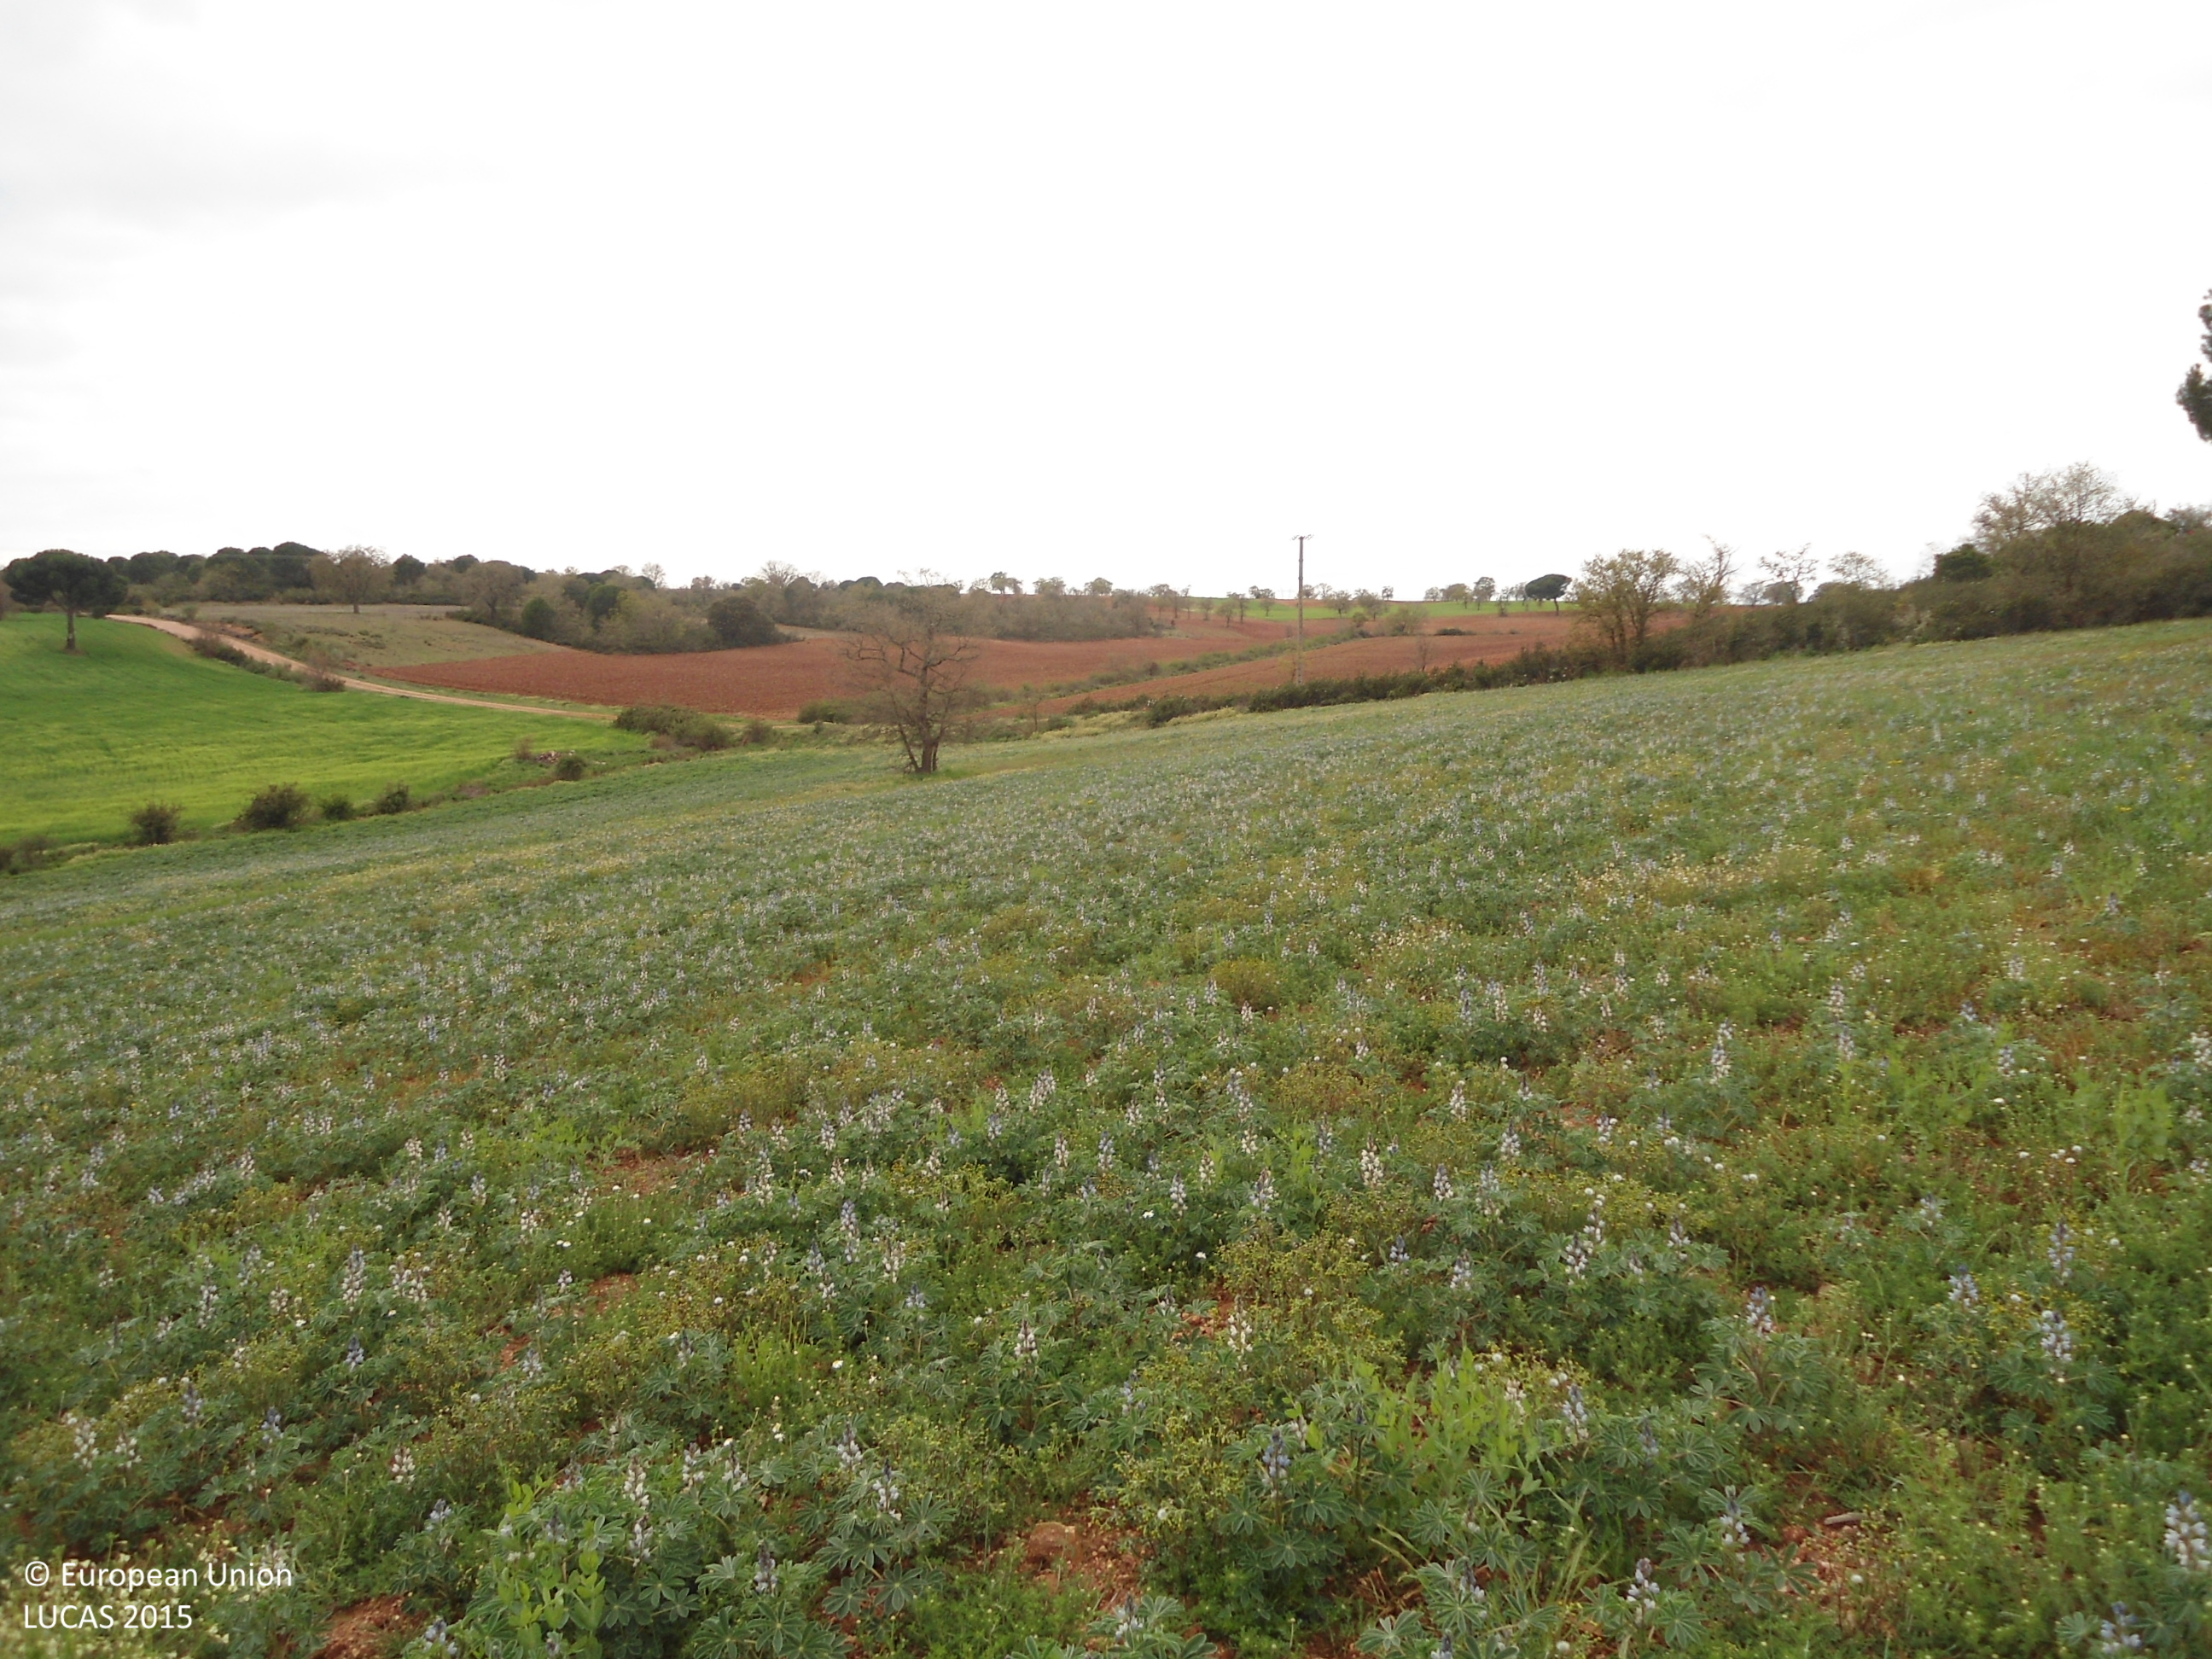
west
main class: Cropland
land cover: Dry pulses
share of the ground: > 75 %
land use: Agriculture (excluding fallow land and kitchen gardens)
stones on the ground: 10 - 25 %
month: April
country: ES
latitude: 41.5609
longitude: -5.8573
